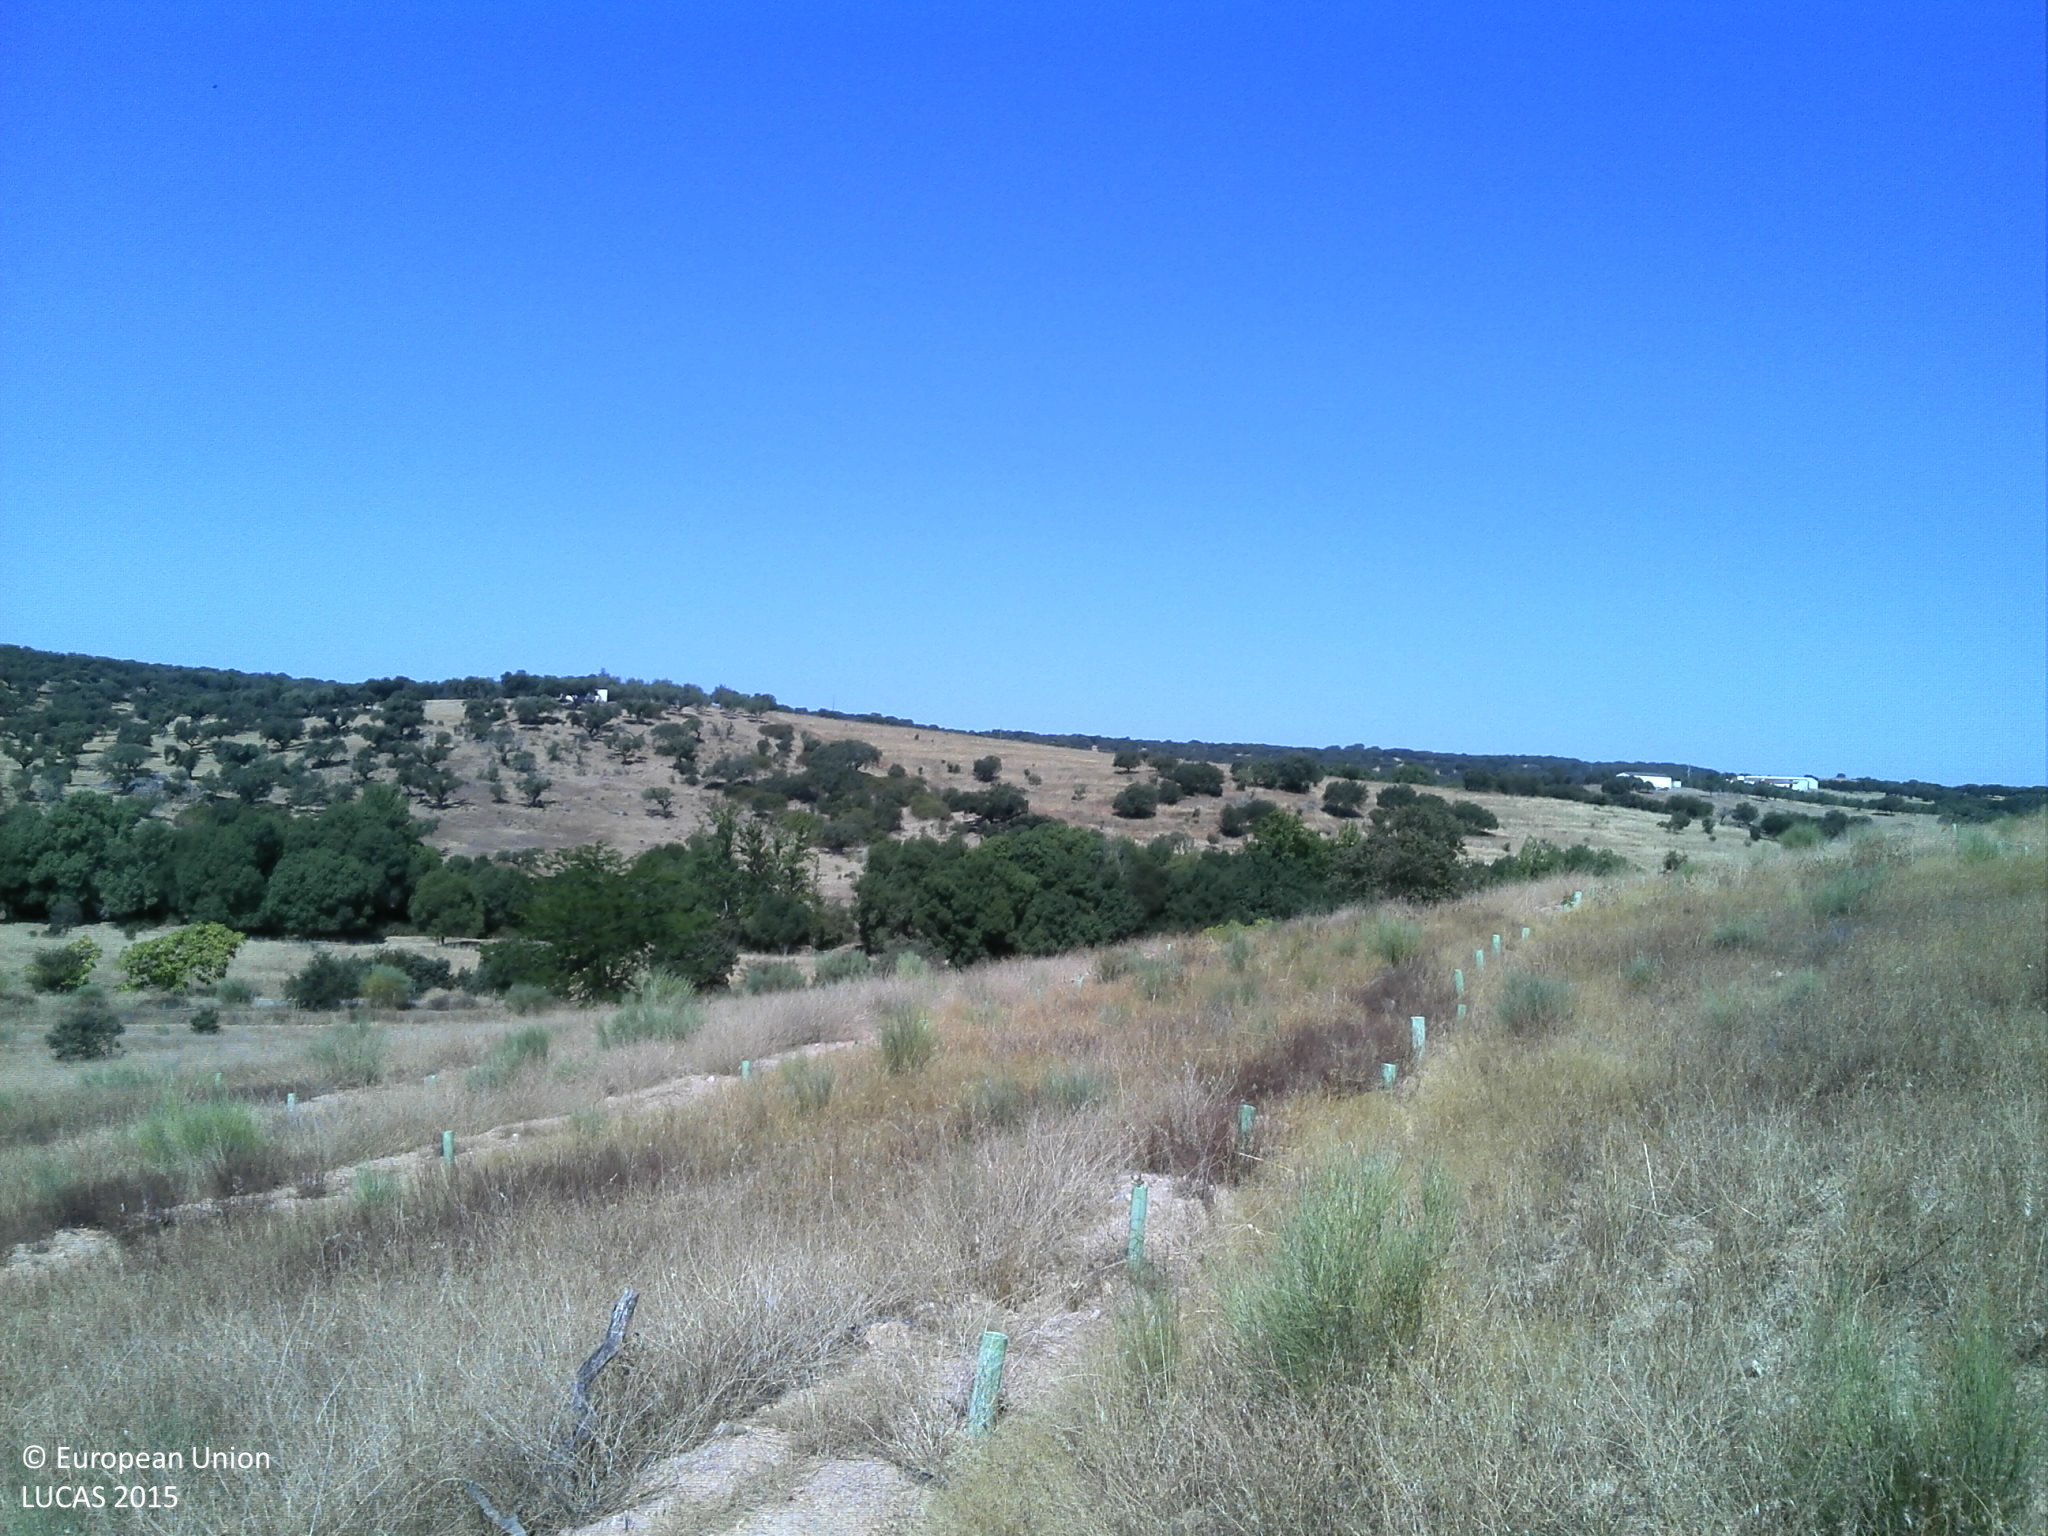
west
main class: Grassland
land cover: Grassland with sparse tree/shrub cover
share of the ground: 25 - 50 %
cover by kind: herbaceous plants 50 %, unconsolidated bare surface 45 %, broadleaved forest trees 5 %
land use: Forestry
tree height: < 5 m
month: July
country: PT
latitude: 39.0802
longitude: -7.4352
